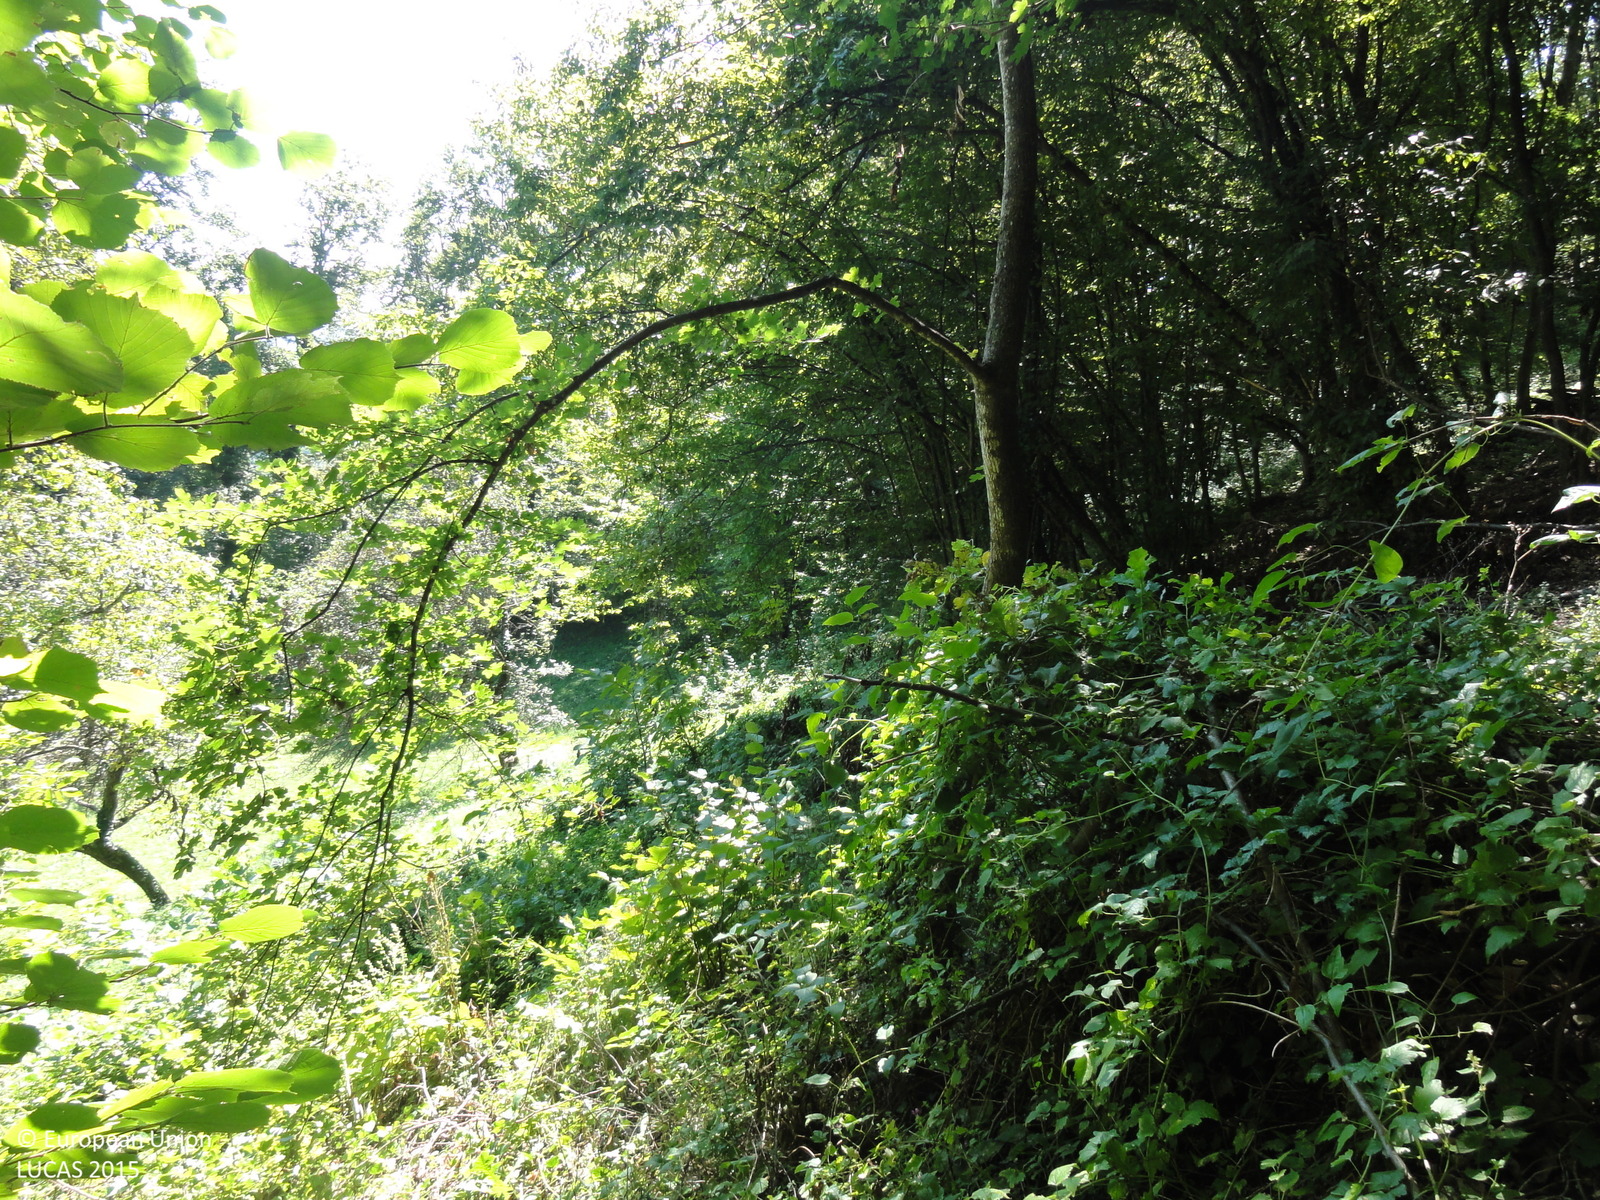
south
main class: Woodland
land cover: Broadleaved woodland
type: mesophytic deciduous forest
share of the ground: > 75 %
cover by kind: broadleaved forest trees 85 %, herbaceous plants 10 %, shrubs 5 %
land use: Forestry
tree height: > 5 m
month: August
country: SI
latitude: 46.0311
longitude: 15.4625
